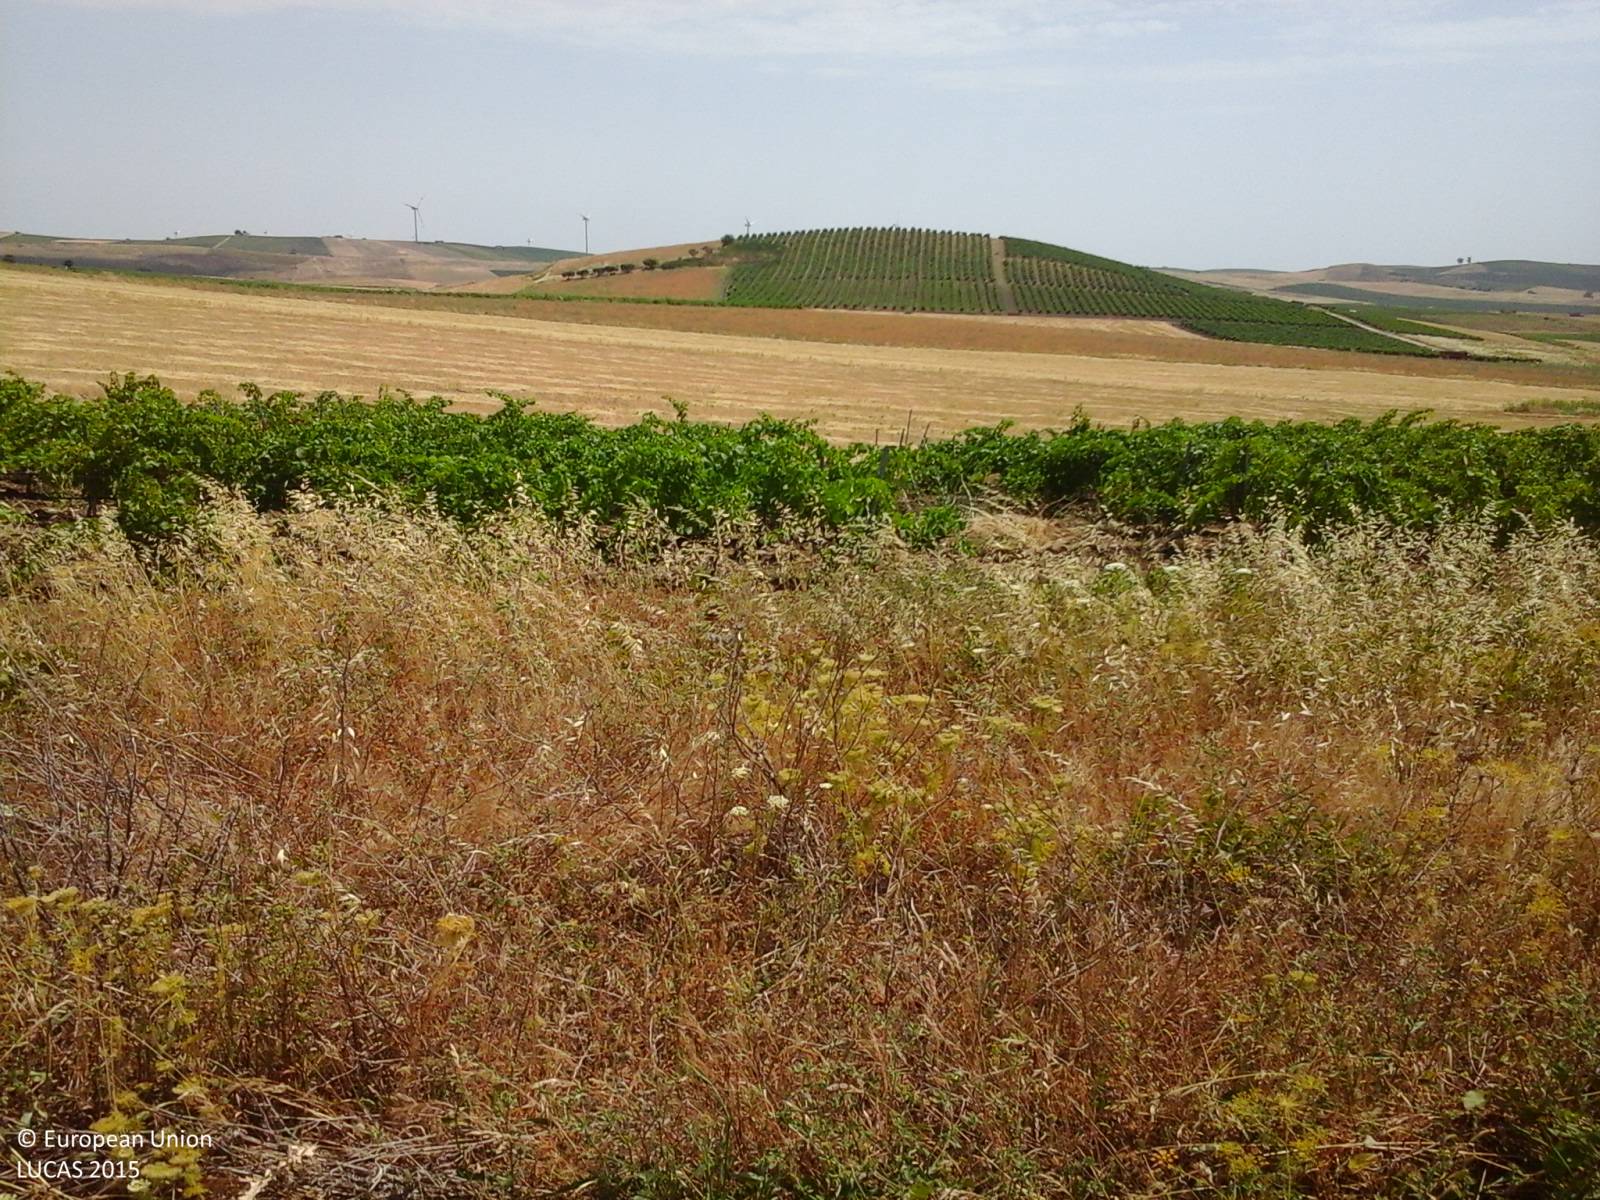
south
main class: Cropland
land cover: Vineyards
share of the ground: 50 - 75 %
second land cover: Other bare soil
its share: > 75 %
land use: Agriculture (excluding fallow land and kitchen gardens)
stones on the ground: < 10 %
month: June
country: IT
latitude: 37.8546
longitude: 12.6964
